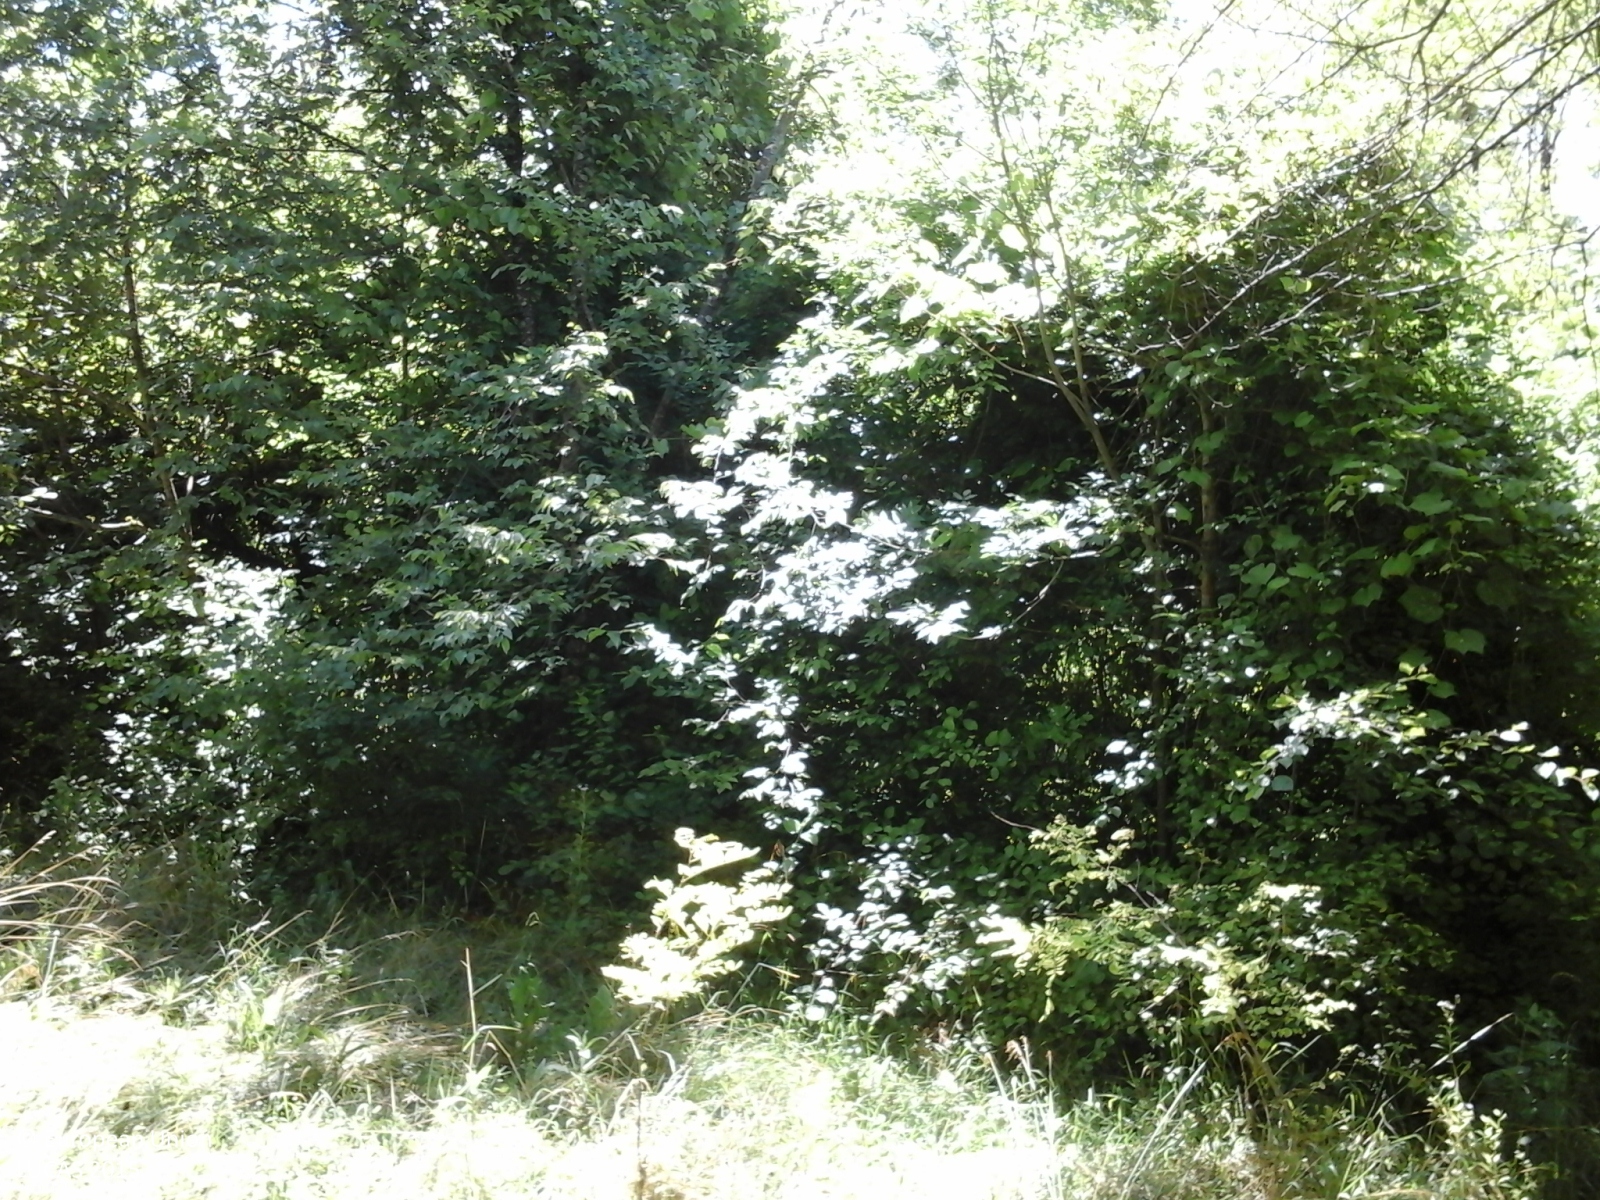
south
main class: Woodland
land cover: Broadleaved woodland
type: mesophytic deciduous forest
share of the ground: > 75 %
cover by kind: broadleaved forest trees 100 %
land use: Semi-natural and natural areas not in use
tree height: > 5 m
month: June
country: IT
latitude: 45.9947
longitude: 11.7406
